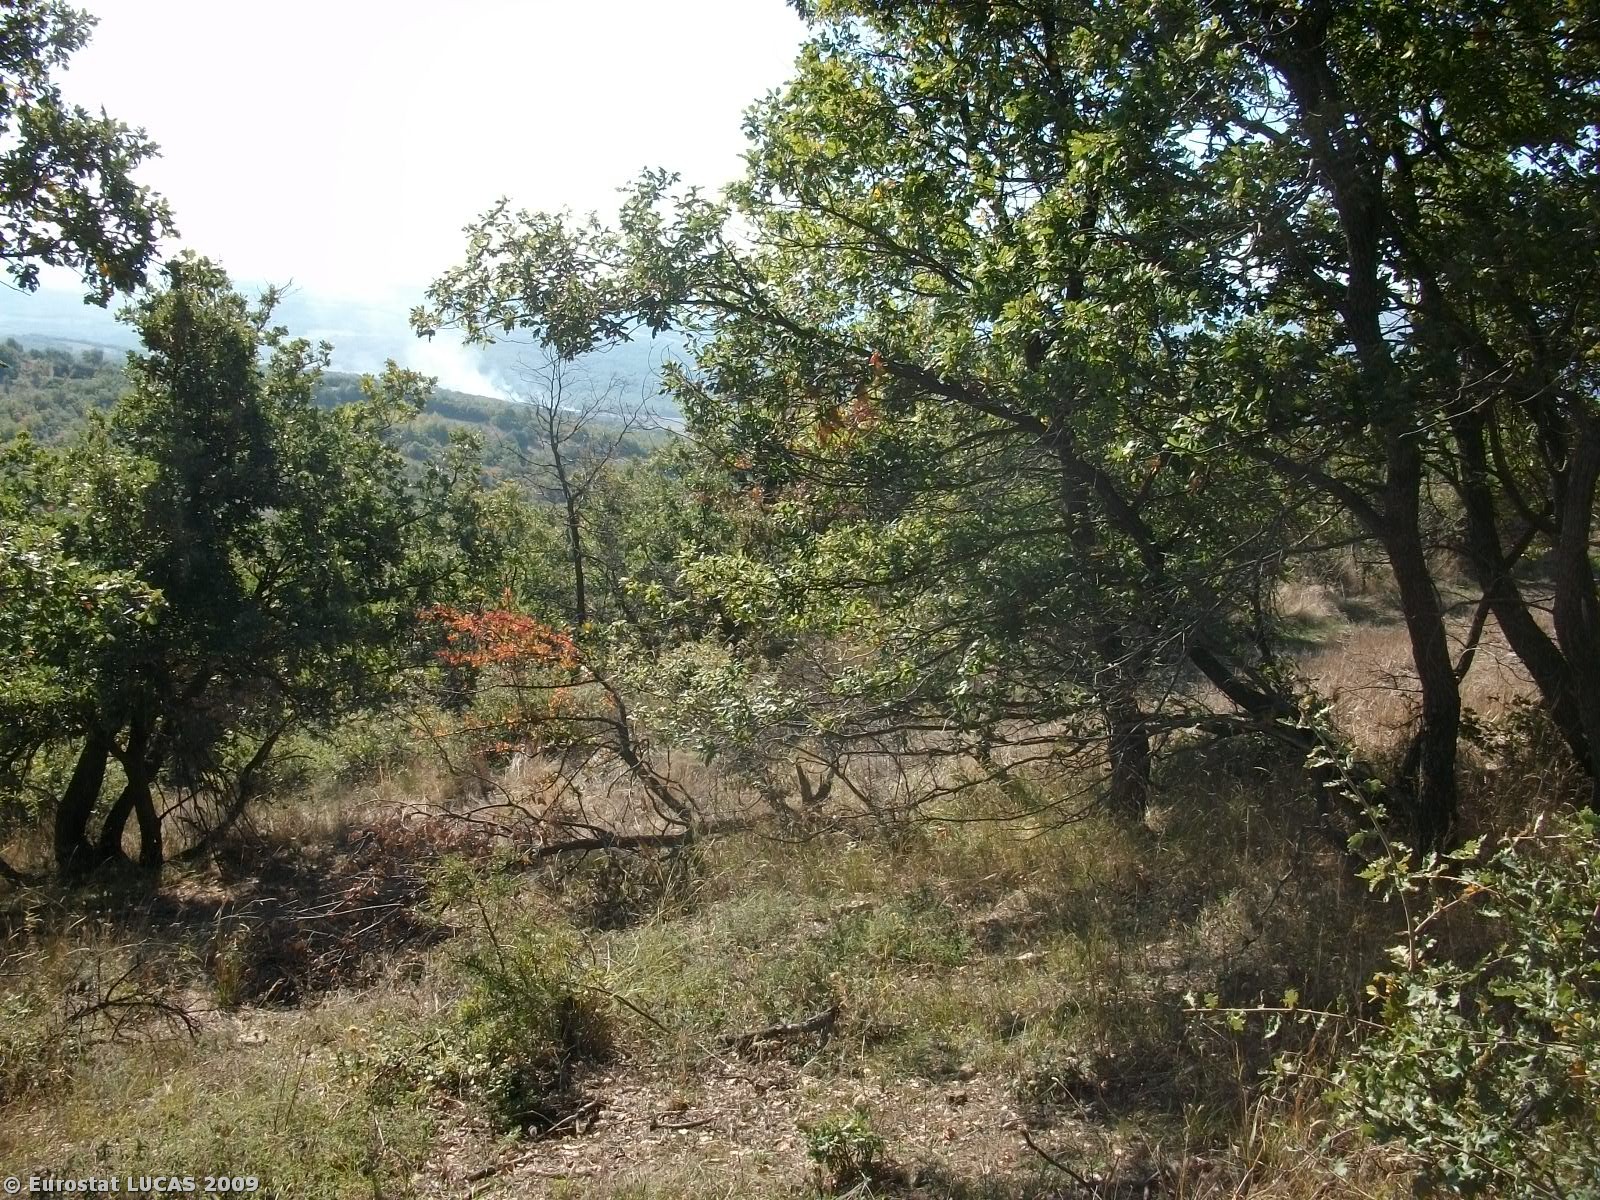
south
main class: Woodland
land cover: Broadleaved woodland
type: thermophilous deciduous forest
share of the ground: 25 - 50 %
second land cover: Grassland with sparse tree/shrub cover
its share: > 75 %
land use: Forestry
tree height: > 5 m
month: October
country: GR
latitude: 39.0829
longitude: 22.4800
